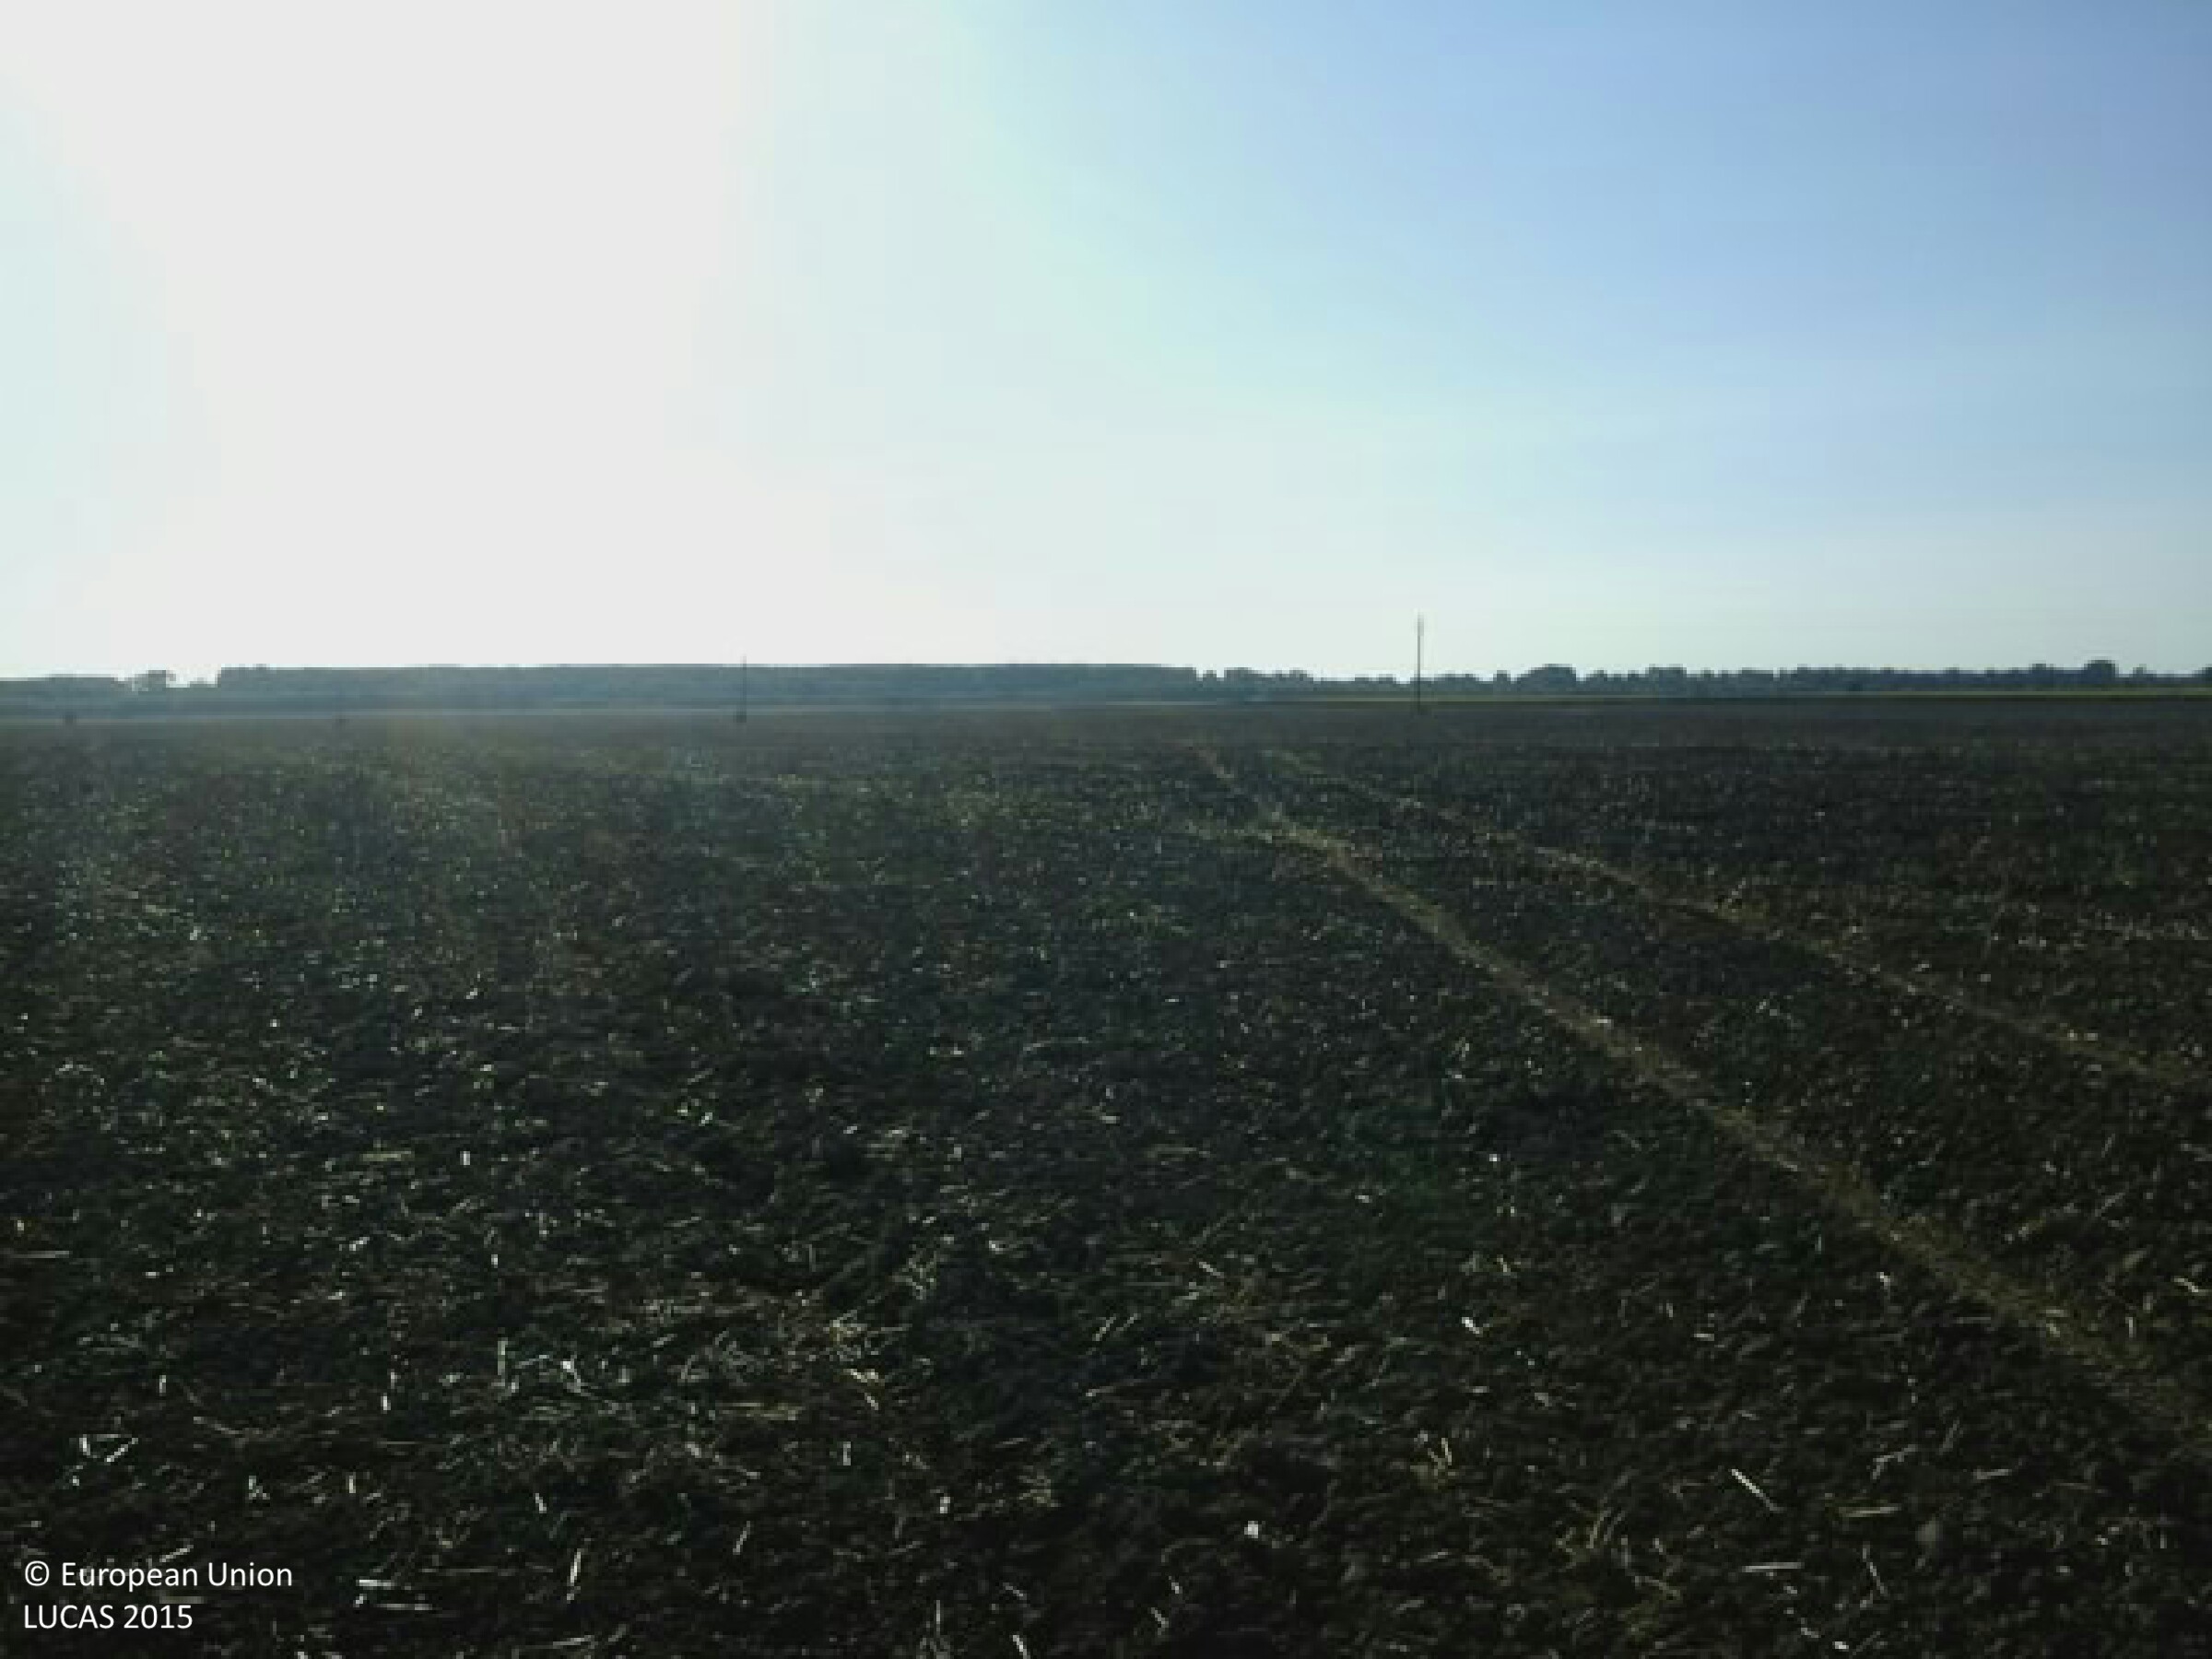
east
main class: Cropland
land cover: Common wheat
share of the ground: < 10 %
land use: Agriculture (excluding fallow land and kitchen gardens)
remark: Harvested field
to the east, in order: Common wheat
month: July
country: HU
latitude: 46.5438
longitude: 18.8675
